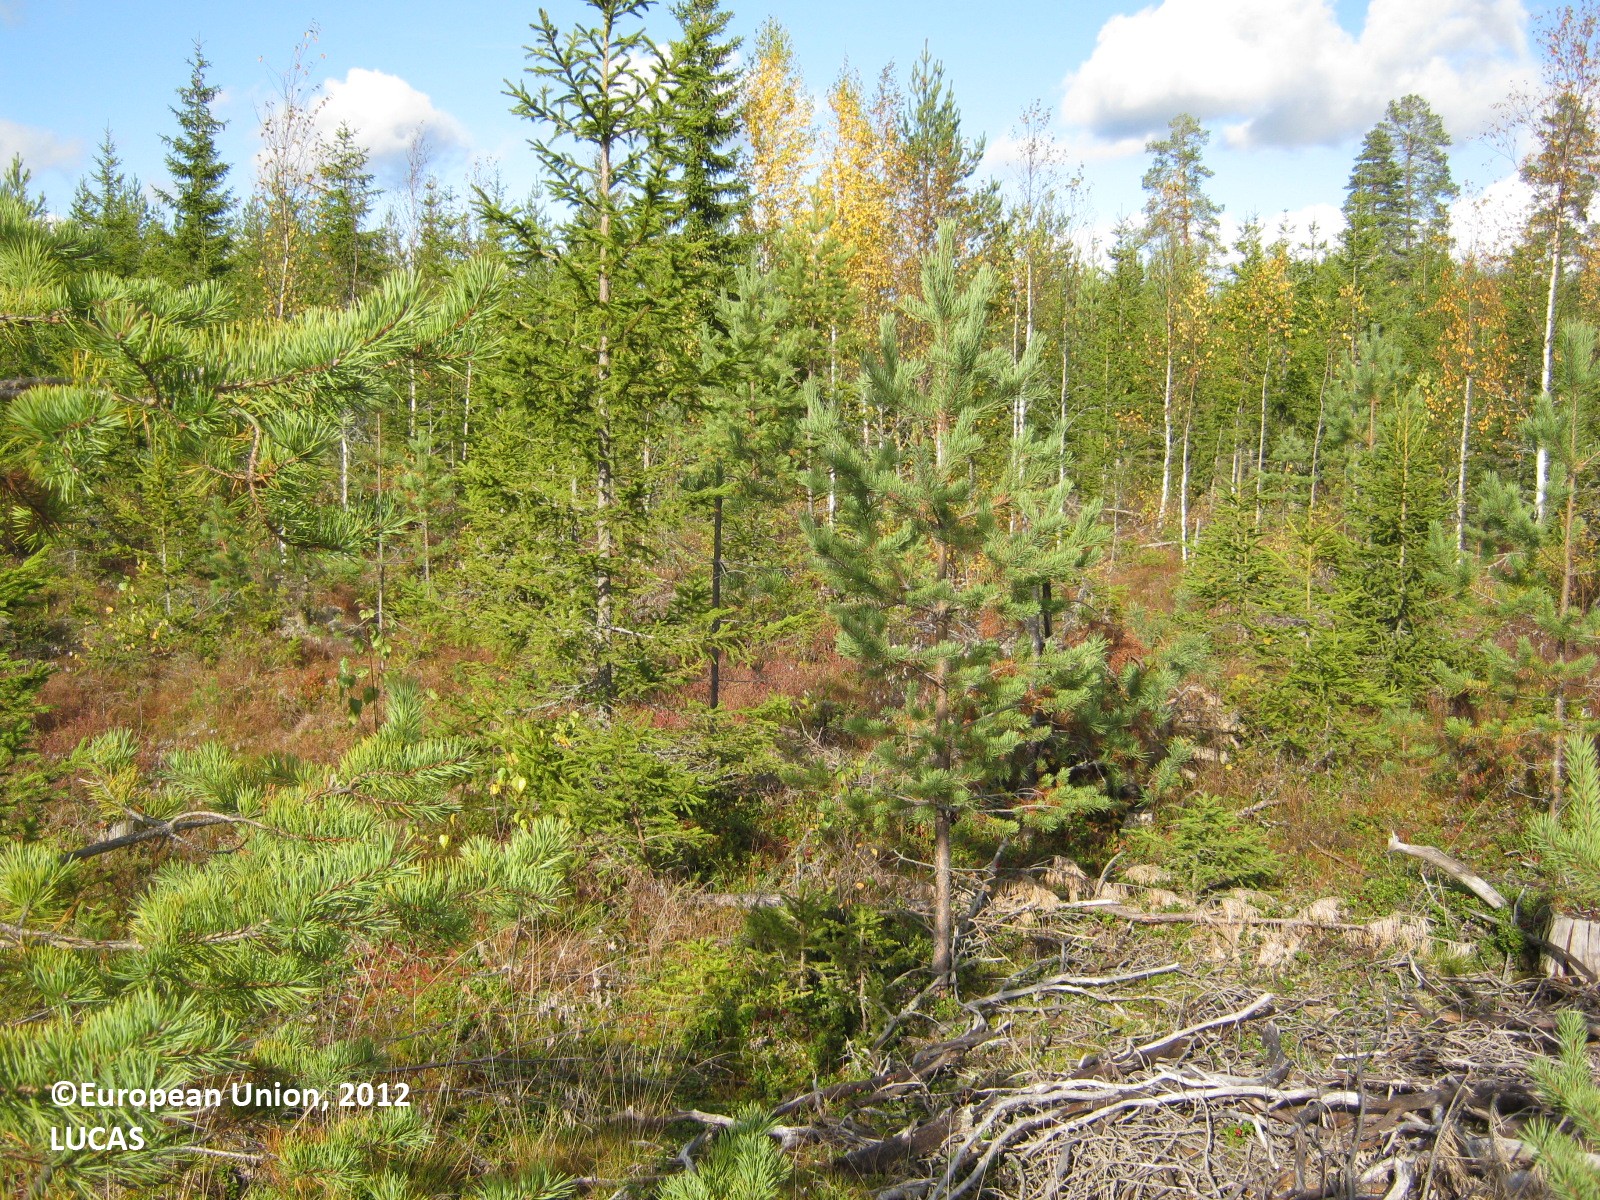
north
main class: Woodland
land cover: Other mixed woodland
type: boreal forest
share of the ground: 50 - 75 %
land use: Forestry
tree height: < 5 m
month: September
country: FI
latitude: 62.2919
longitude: 28.8991
